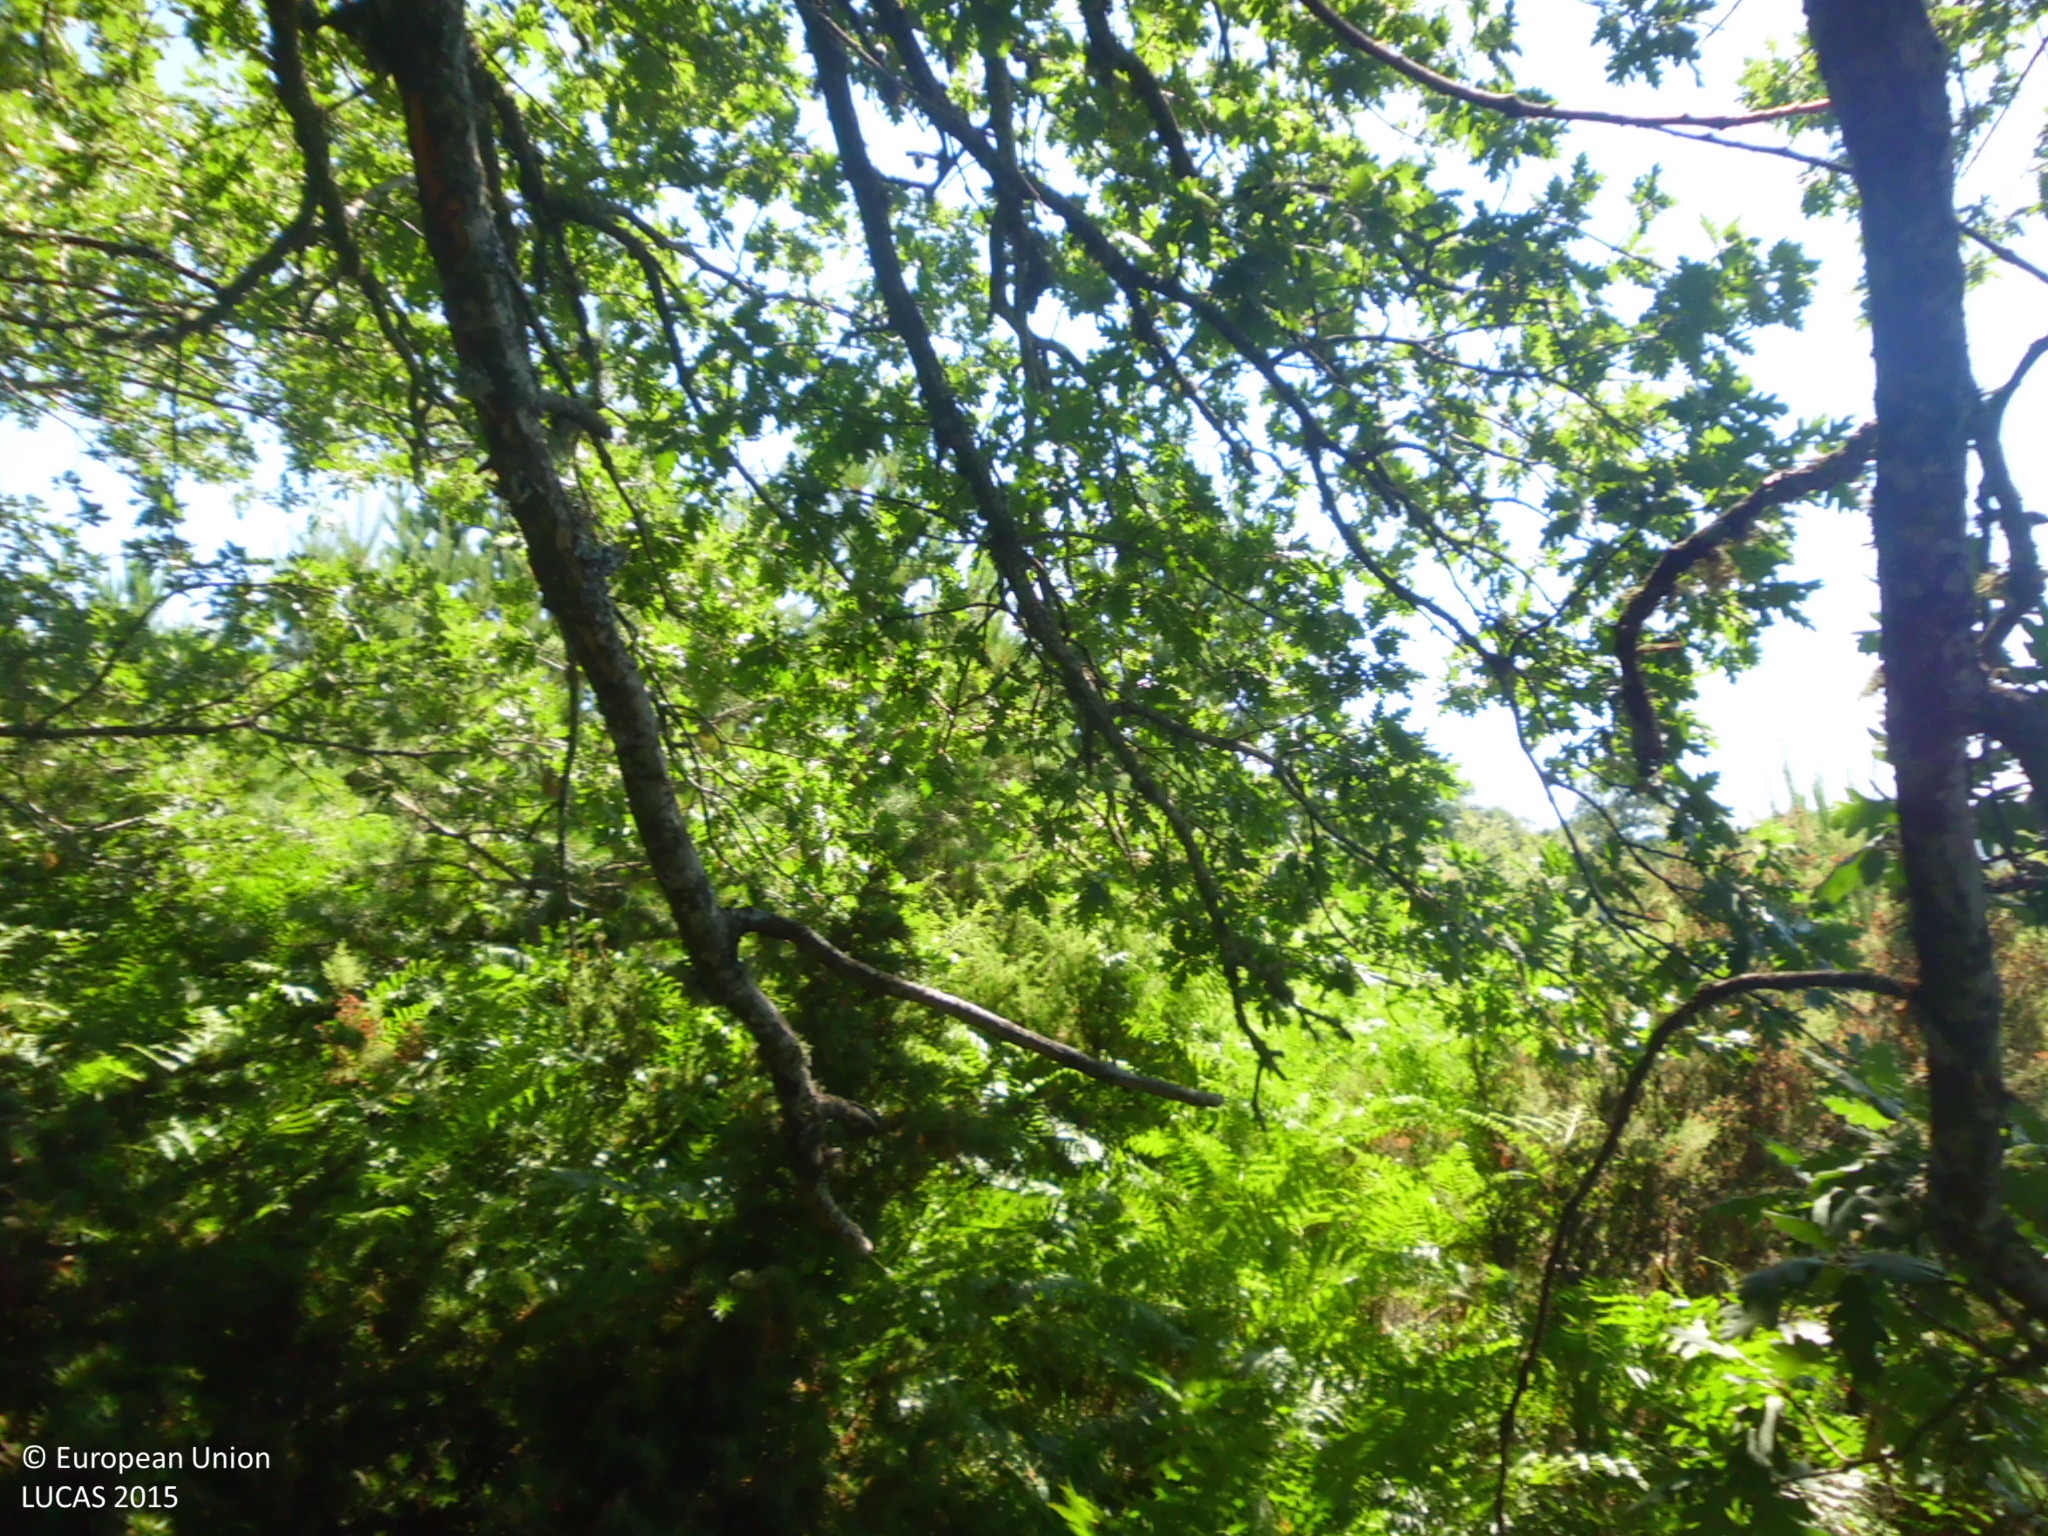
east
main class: Woodland
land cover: Broadleaved woodland
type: acidophilous oak and oak-birch forest
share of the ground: 10 - 25 %
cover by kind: shrubs 60 %, broadleaved forest trees 20 %, herbaceous plants 20 %
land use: Agriculture (excluding fallow land and kitchen gardens)
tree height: > 5 m
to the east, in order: Broadleaved woodland; Shrubland with sparse tree cover
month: July
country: ES
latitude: 42.3155
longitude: -3.3405
